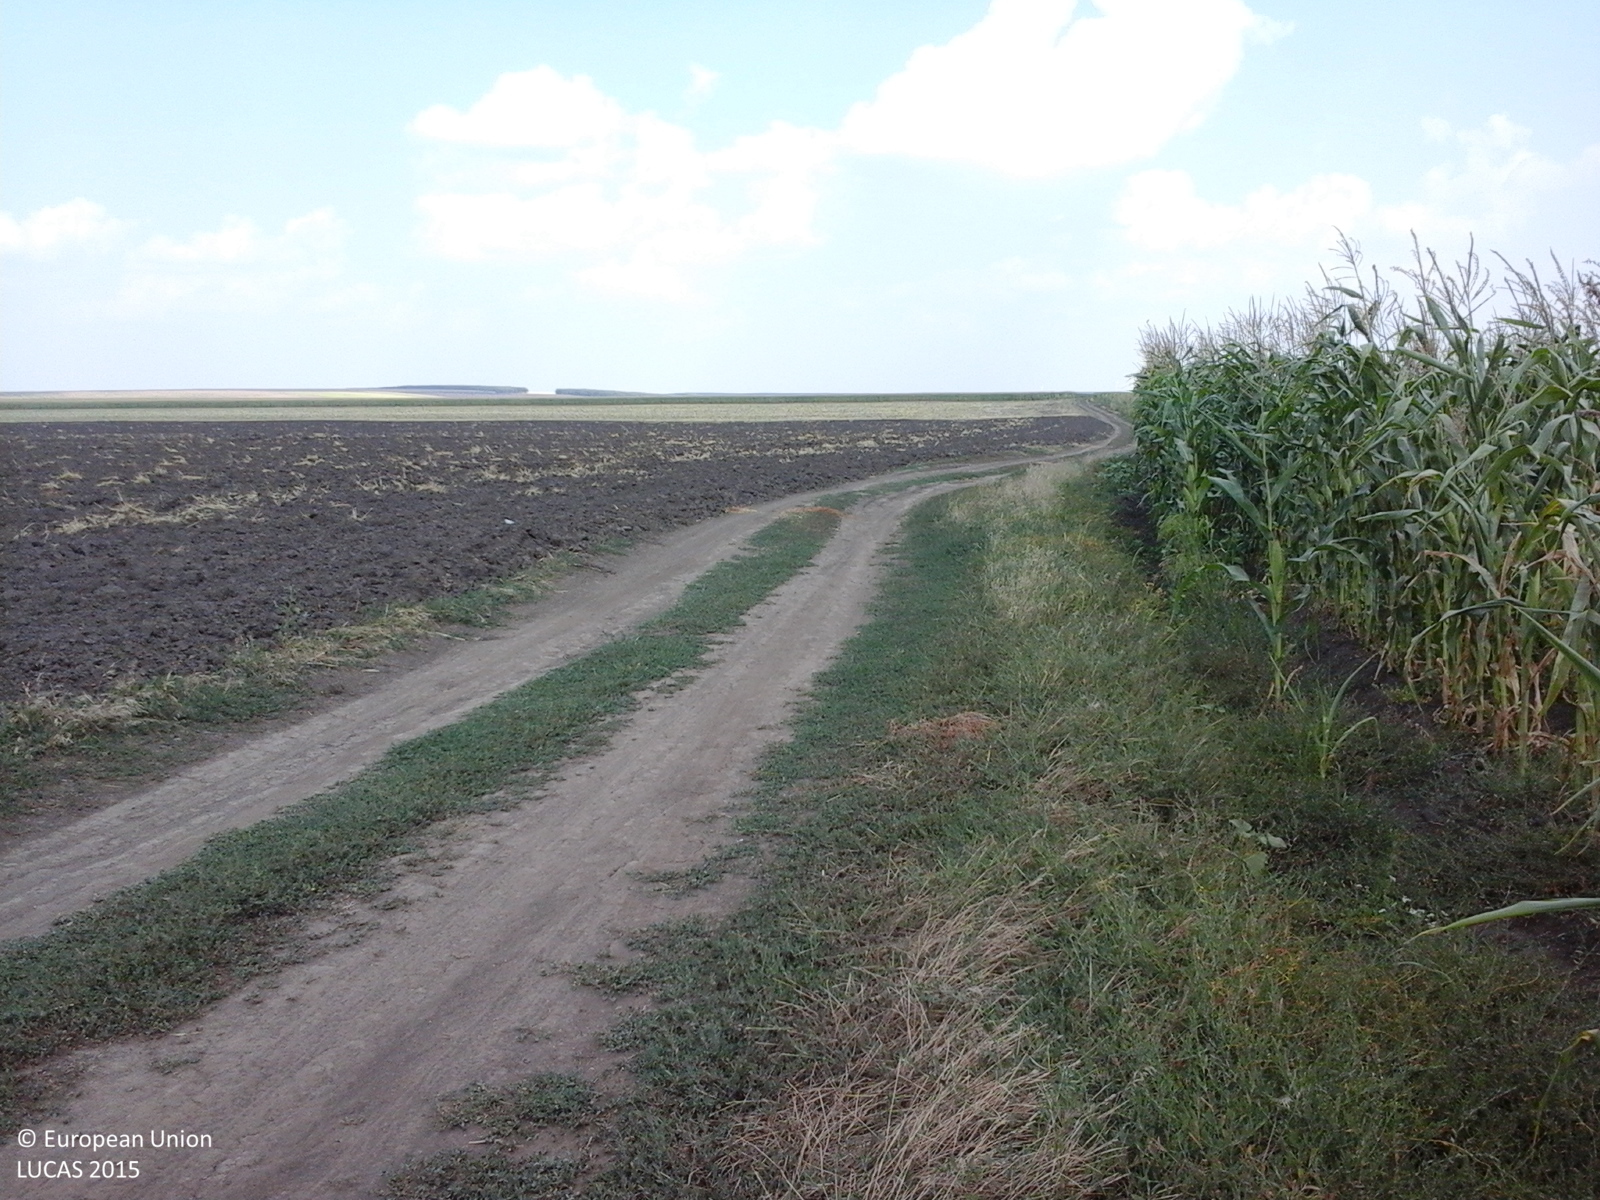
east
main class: Cropland
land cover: Maize
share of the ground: > 75 %
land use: Agriculture (excluding fallow land and kitchen gardens)
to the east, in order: Maize; Grass margins; Tracks; Common wheat
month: July
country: RO
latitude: 45.8689
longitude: 27.6157
